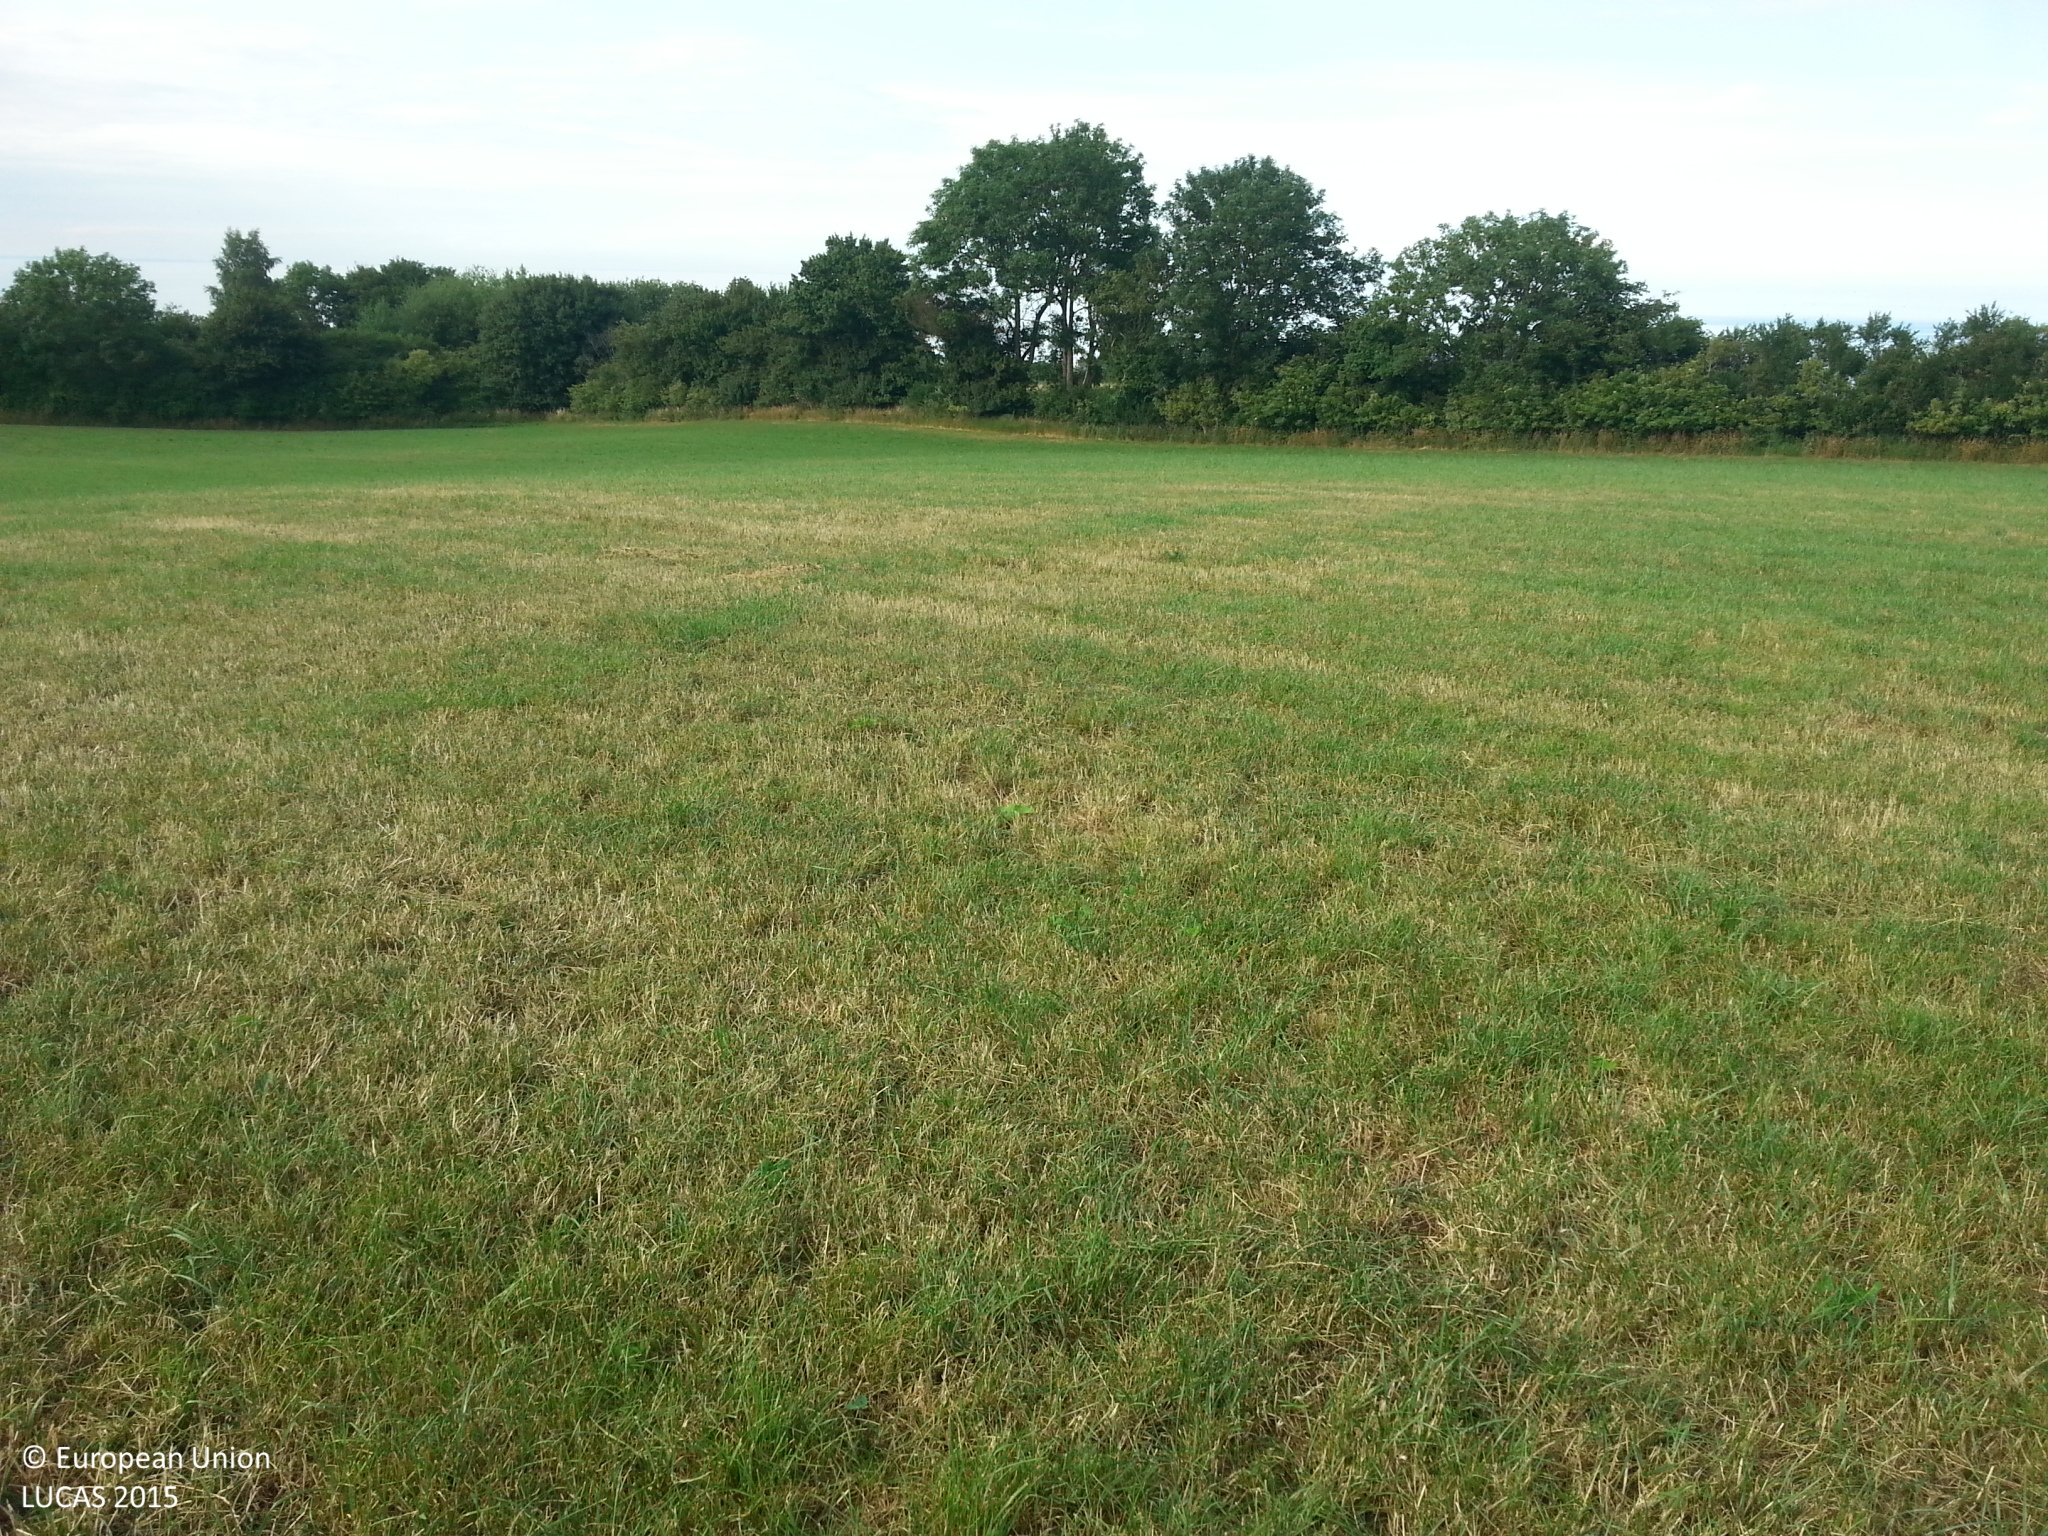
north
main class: Grassland
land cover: Grassland without tree/shrub cover
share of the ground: > 75 %
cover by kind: herbaceous plants 100 %
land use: Agriculture (excluding fallow land and kitchen gardens)
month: July
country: DE
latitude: 54.0076
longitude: 11.1438
